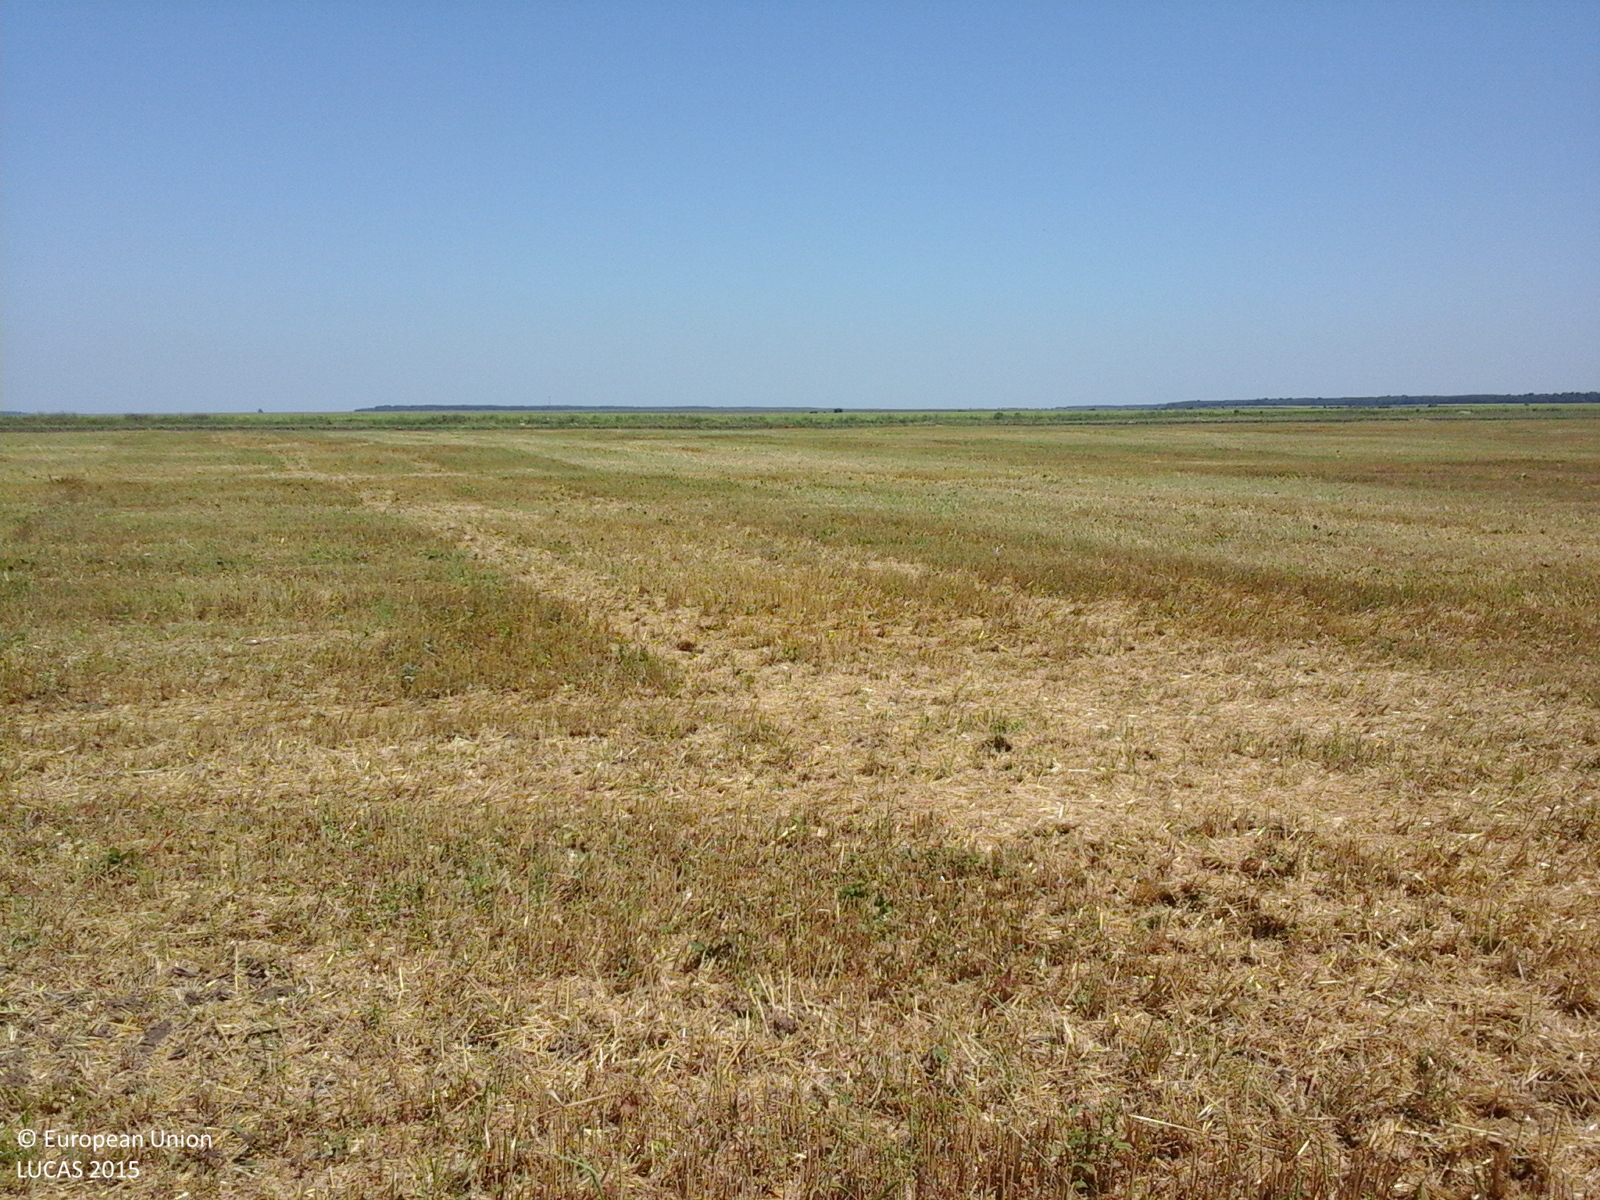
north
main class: Cropland
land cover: Common wheat
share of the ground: 10 - 25 %
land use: Agriculture (excluding fallow land and kitchen gardens)
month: July
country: RO
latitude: 44.3016
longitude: 26.5219
